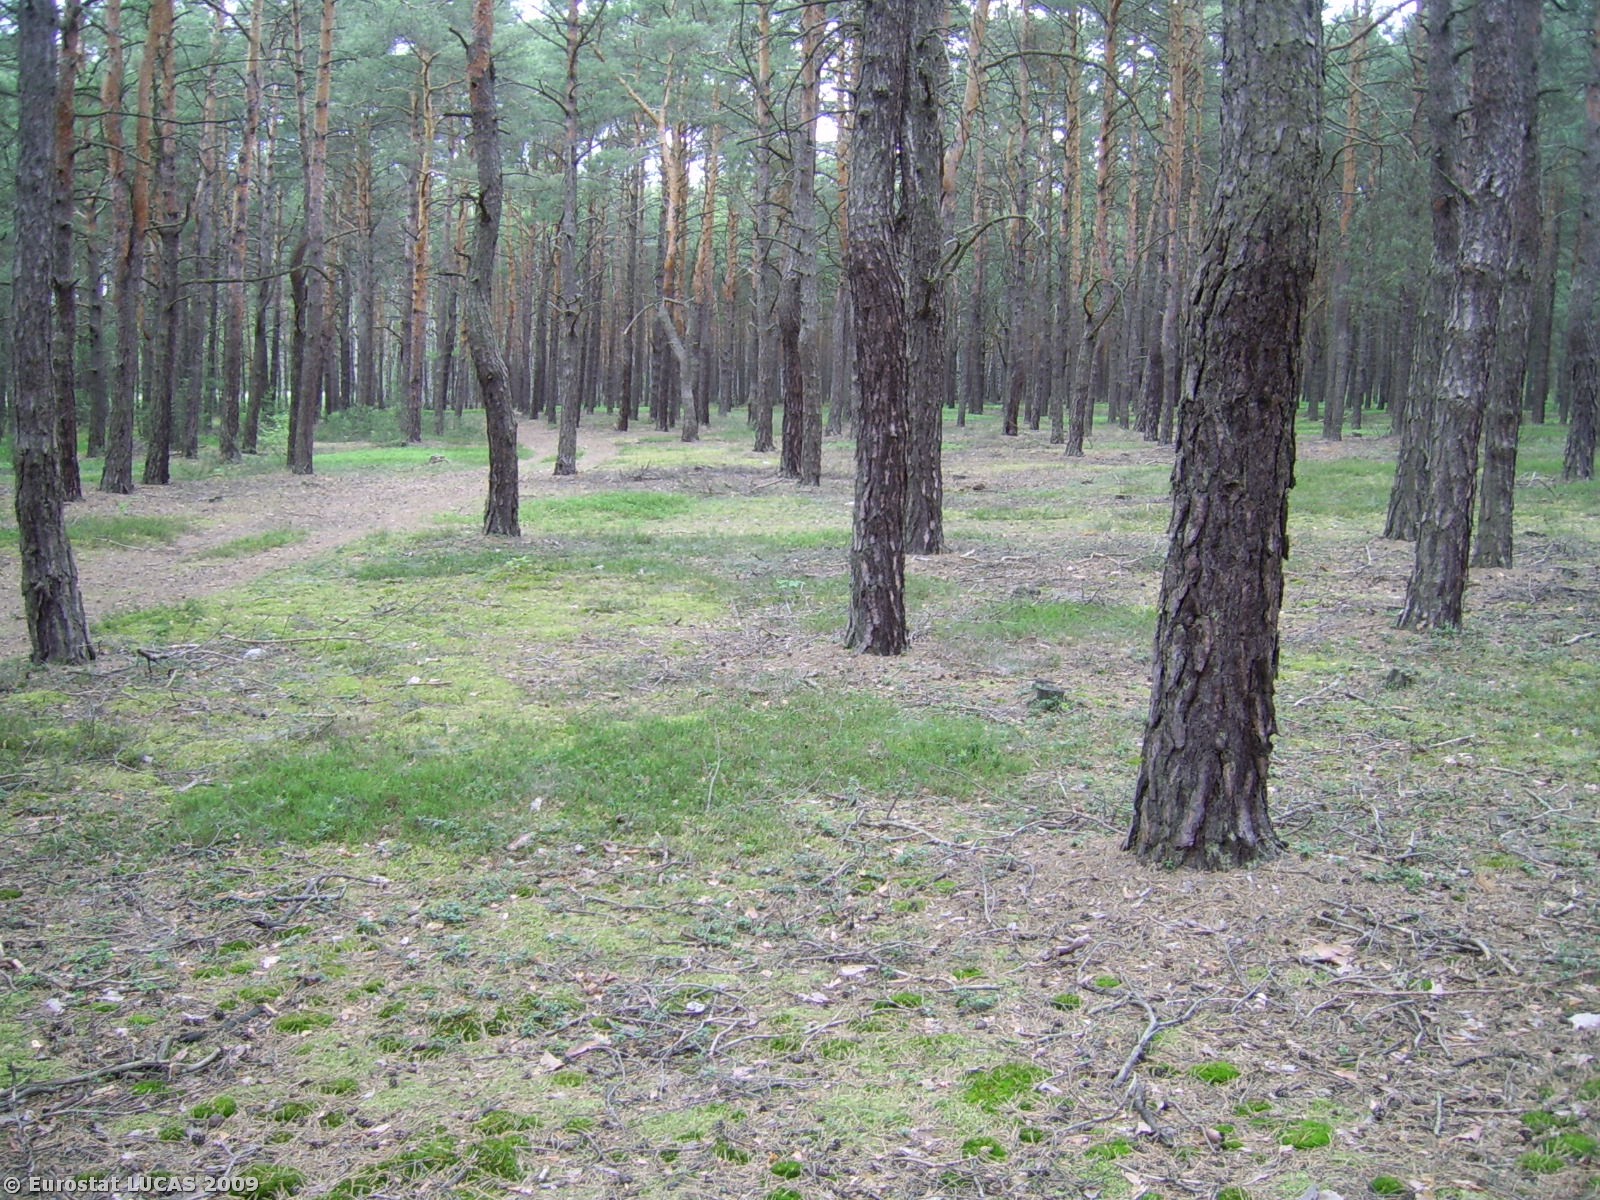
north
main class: Woodland
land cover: Coniferous woodland
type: hemiboreal forest and nemoral coniferous forest and mixed broadleaved-coniferous forest
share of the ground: 50 - 75 %
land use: Forestry
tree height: > 5 m
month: June
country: PL
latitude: 52.0493
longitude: 17.7865
